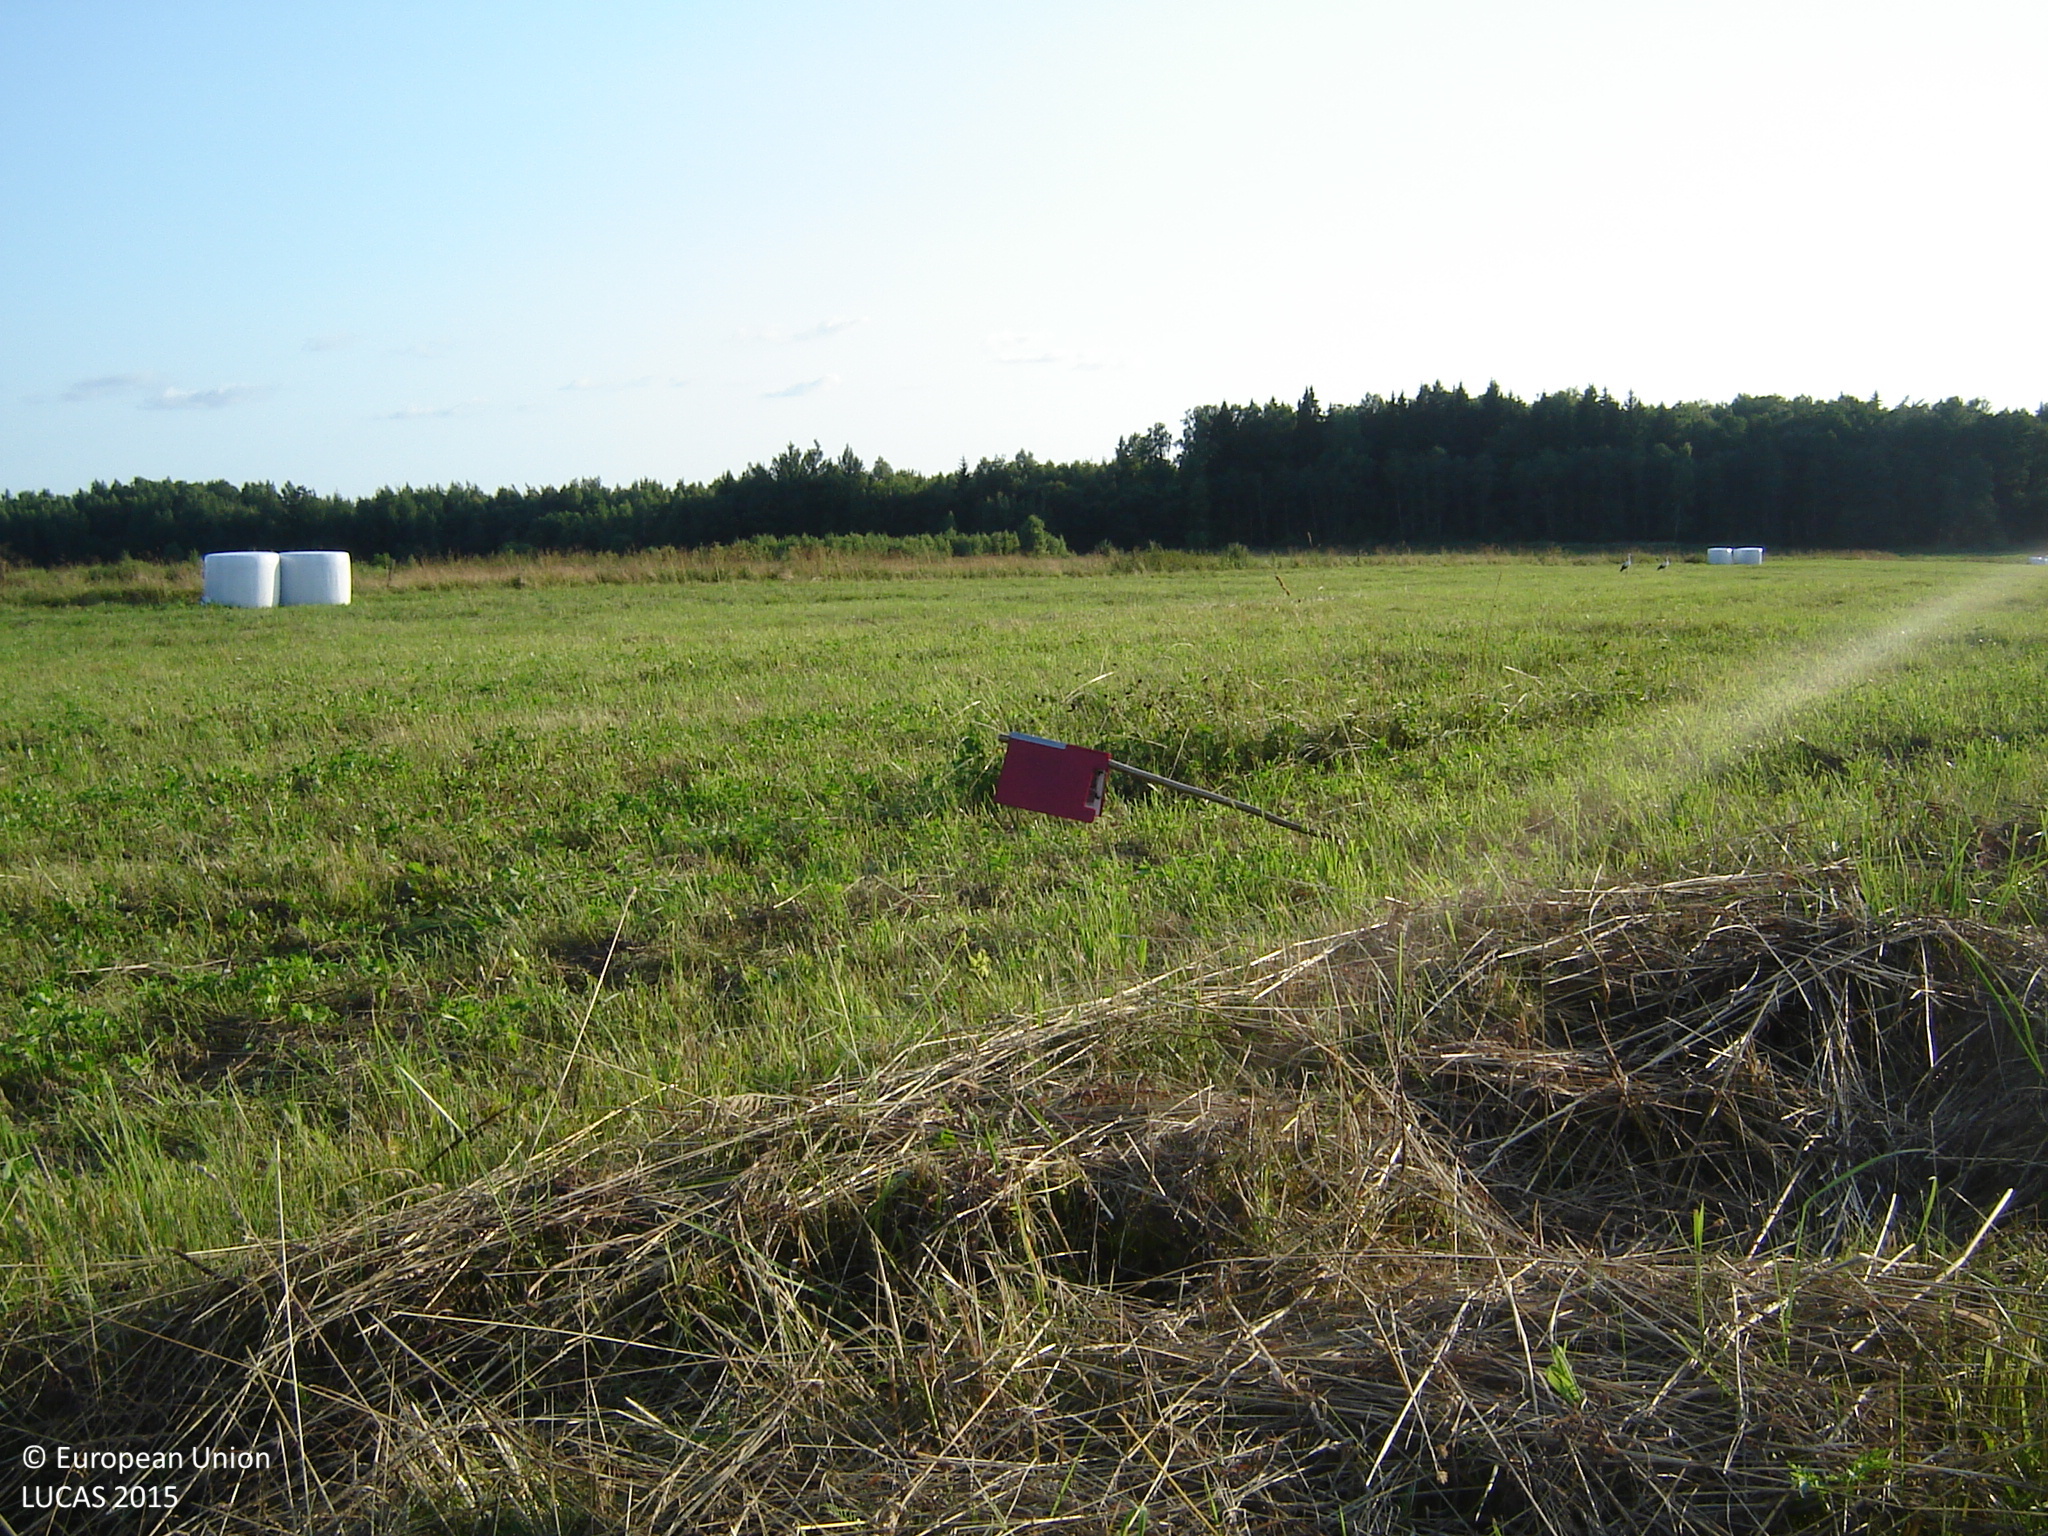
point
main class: Grassland
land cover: Grassland without tree/shrub cover
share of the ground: > 75 %
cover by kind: herbaceous plants 100 %
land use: Agriculture (excluding fallow land and kitchen gardens)
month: July
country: LT
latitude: 55.4706
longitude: 25.0947
